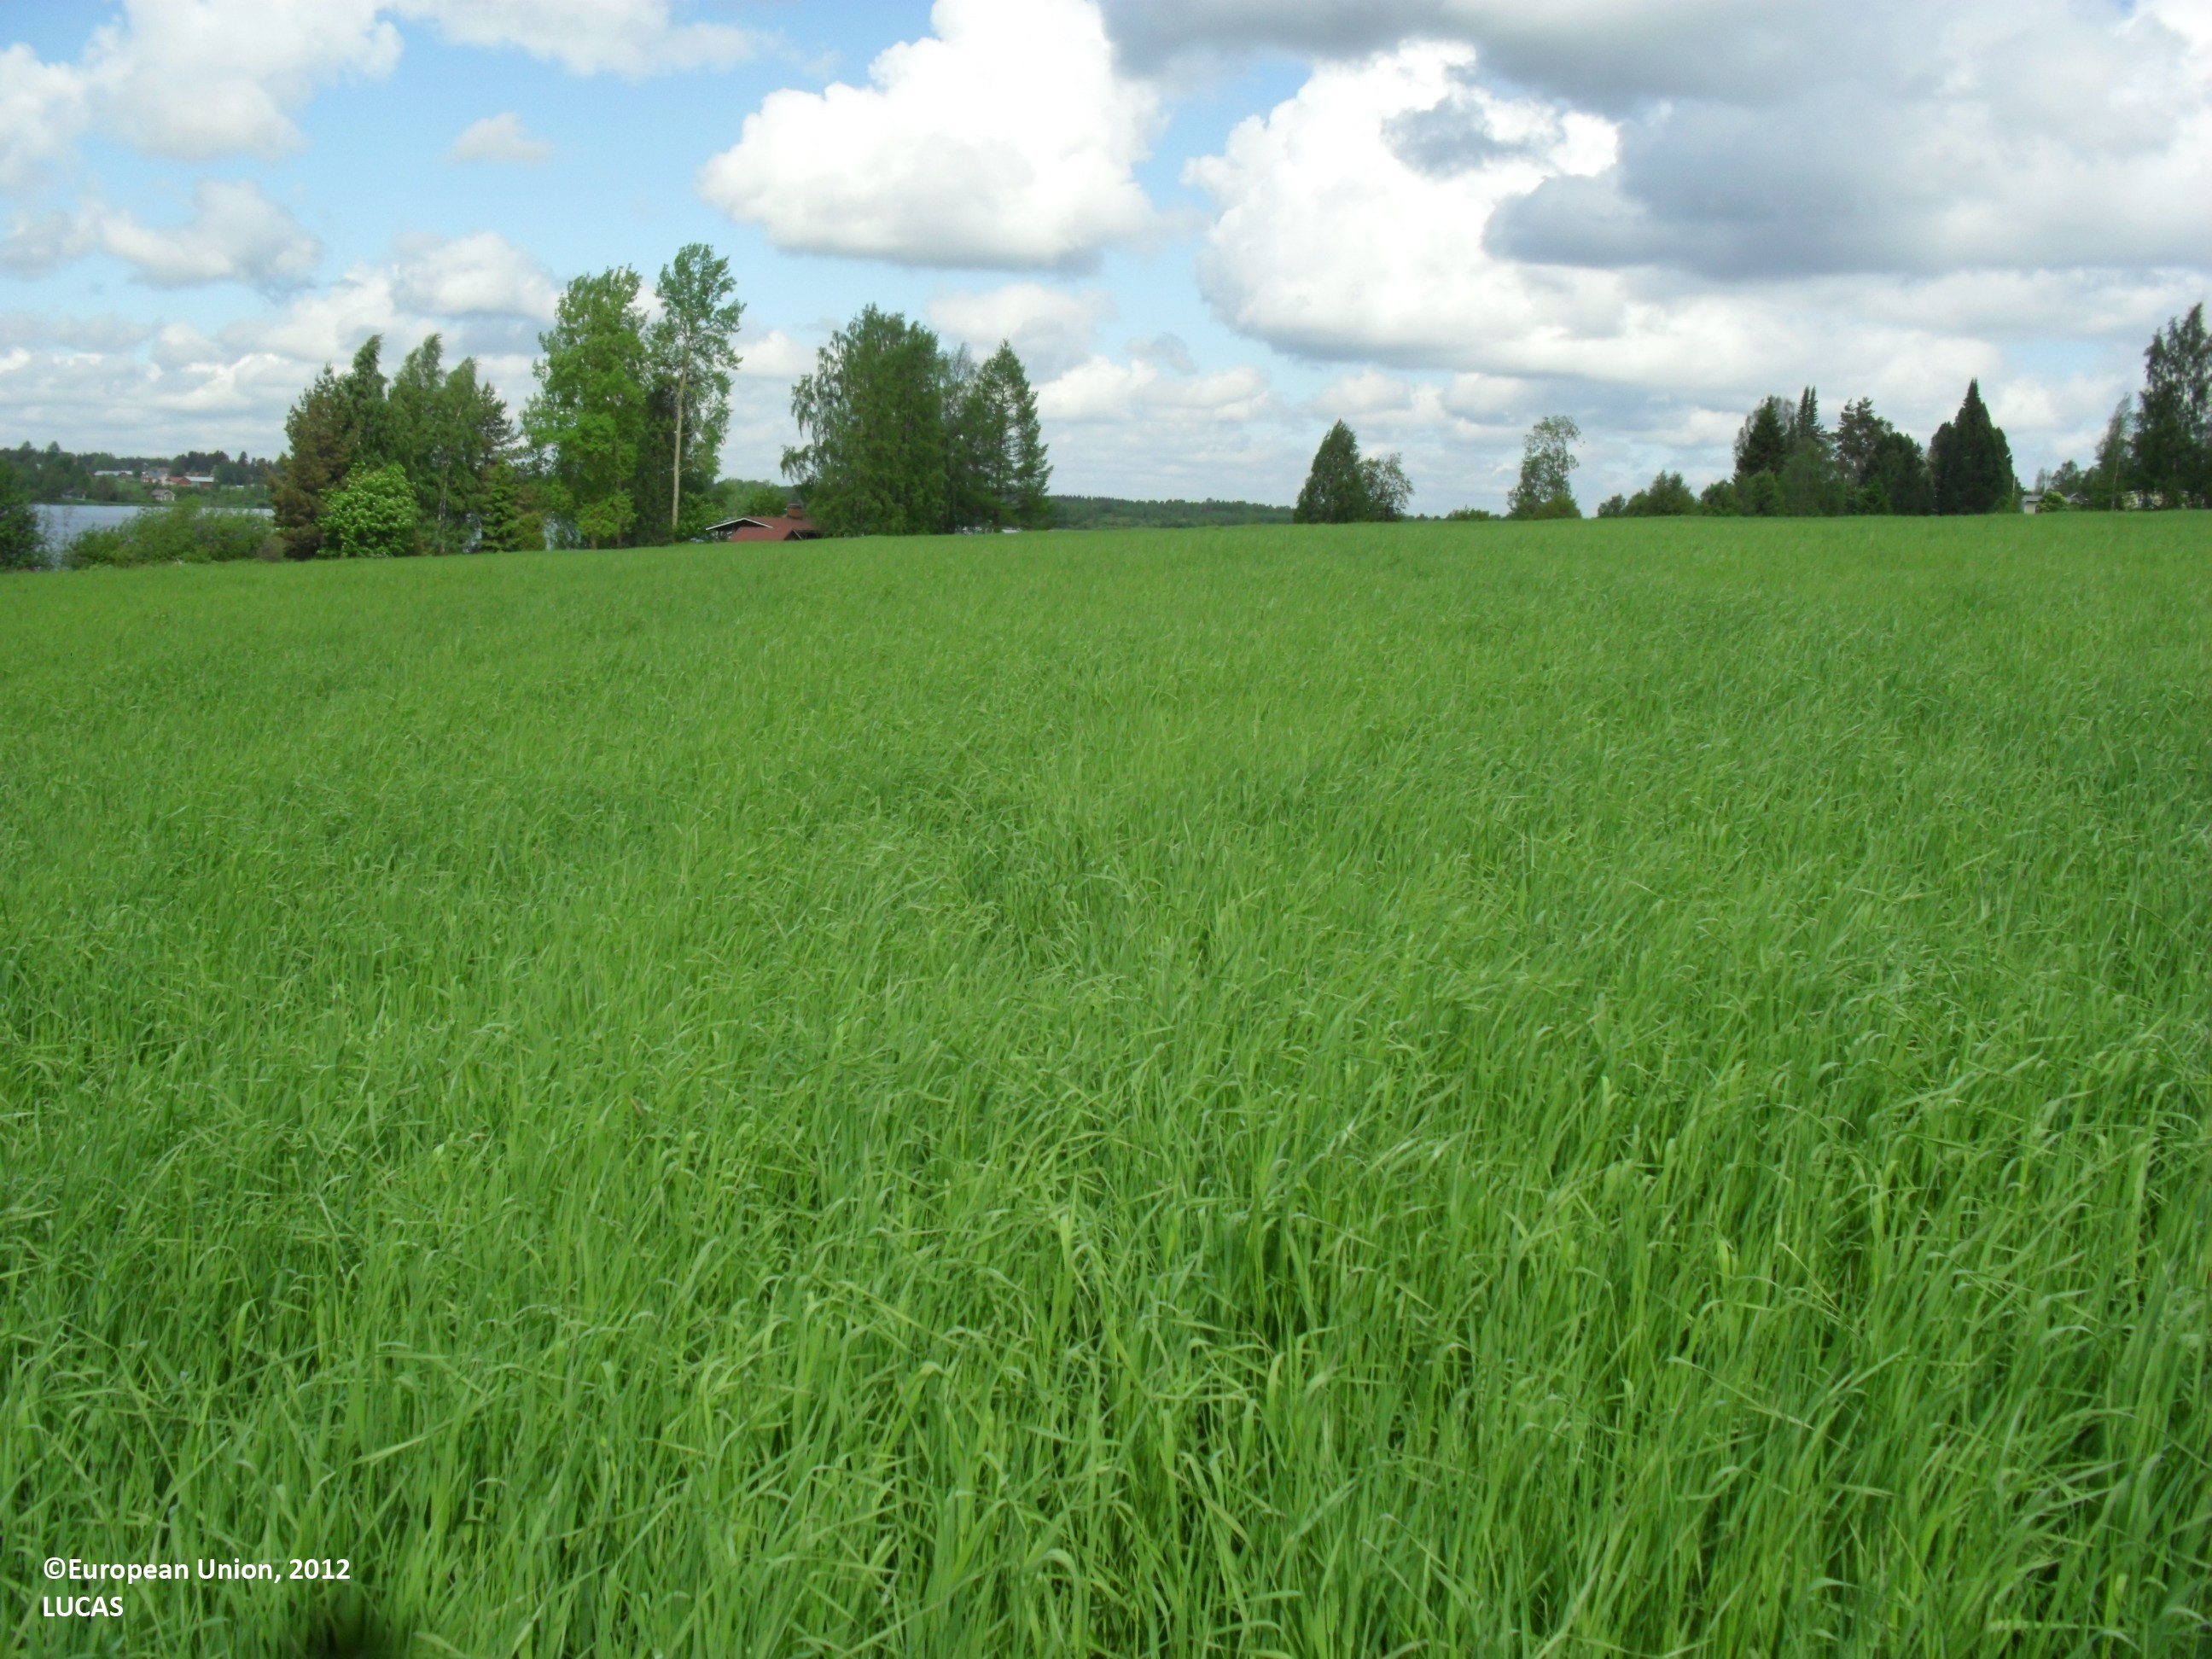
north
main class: Cropland
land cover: Temporary grasslands
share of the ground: > 75 %
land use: Agriculture (excluding fallow land and kitchen gardens)
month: June
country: FI
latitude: 62.7512
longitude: 23.5188
